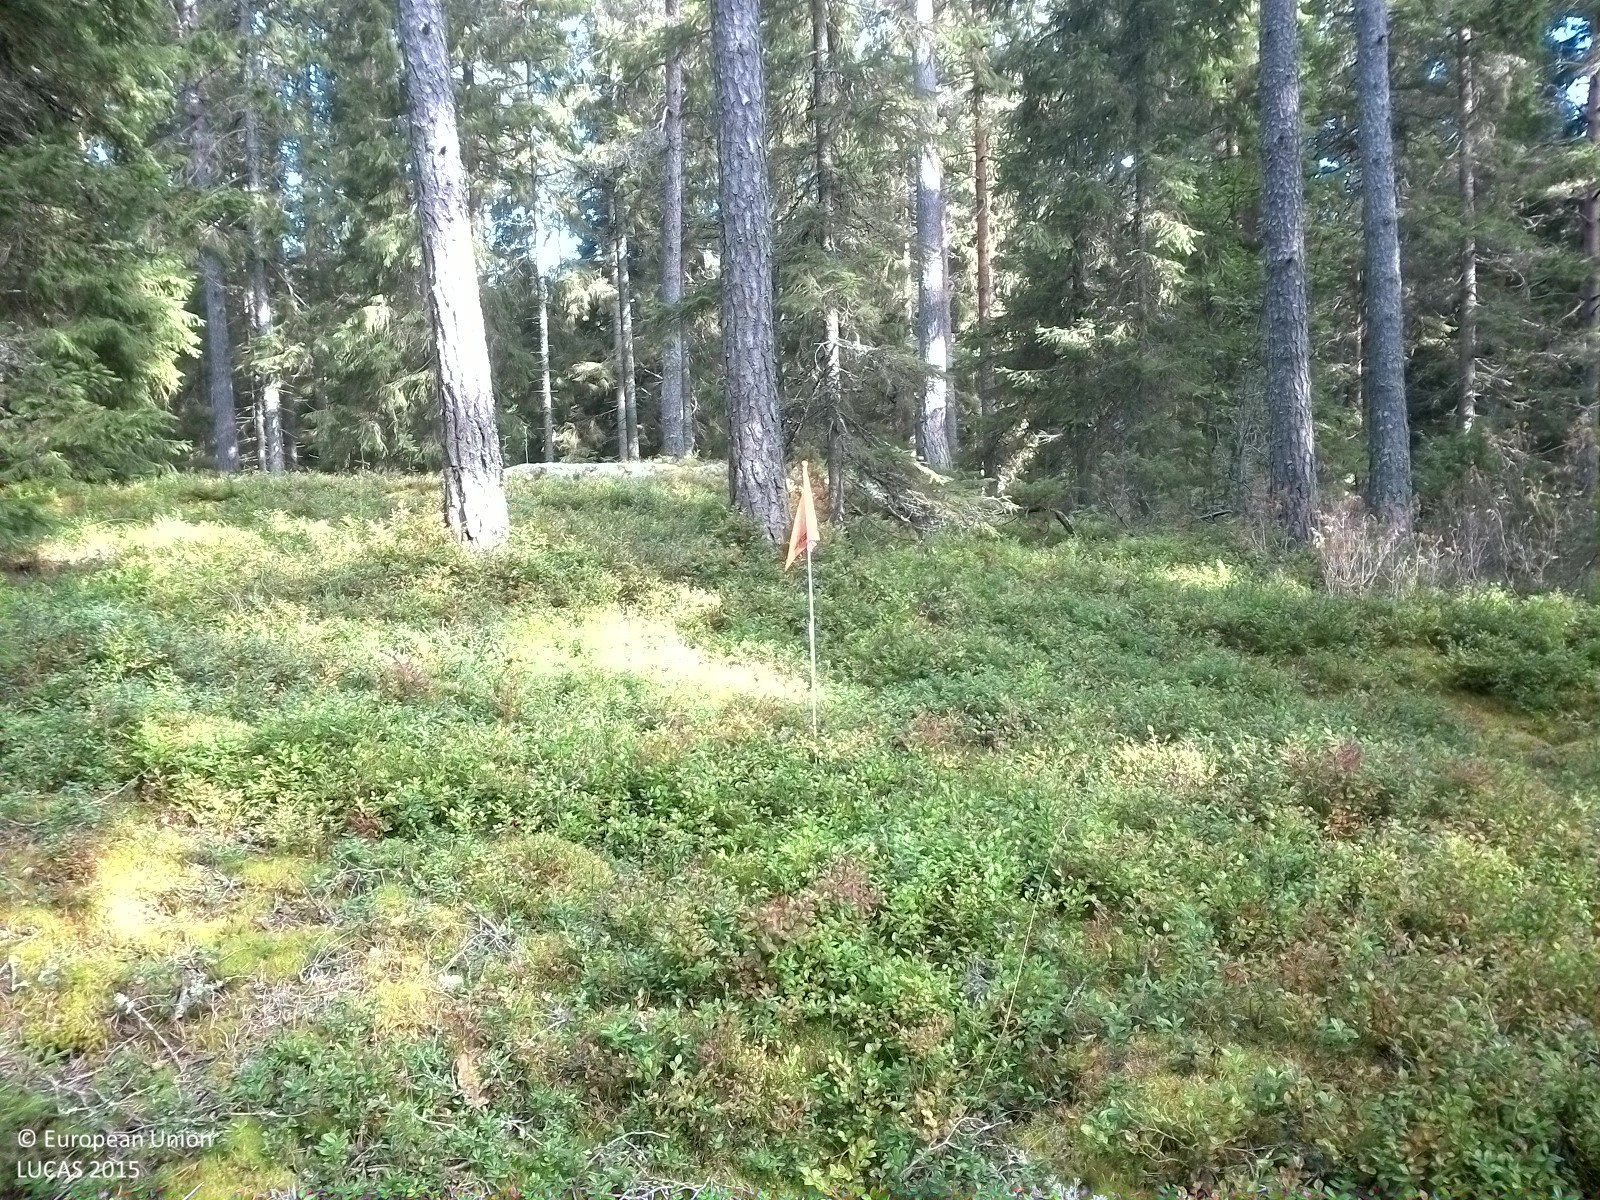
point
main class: Woodland
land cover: Pine dominated coniferous woodland
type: boreal forest
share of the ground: 25 - 50 %
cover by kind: shrubs 60 %, coniferous forest trees 25 %, herbaceous plants 10 %, lichens and mosses 5 %
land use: Forestry
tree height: > 5 m
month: August
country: SE
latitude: 58.7195
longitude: 15.0524
